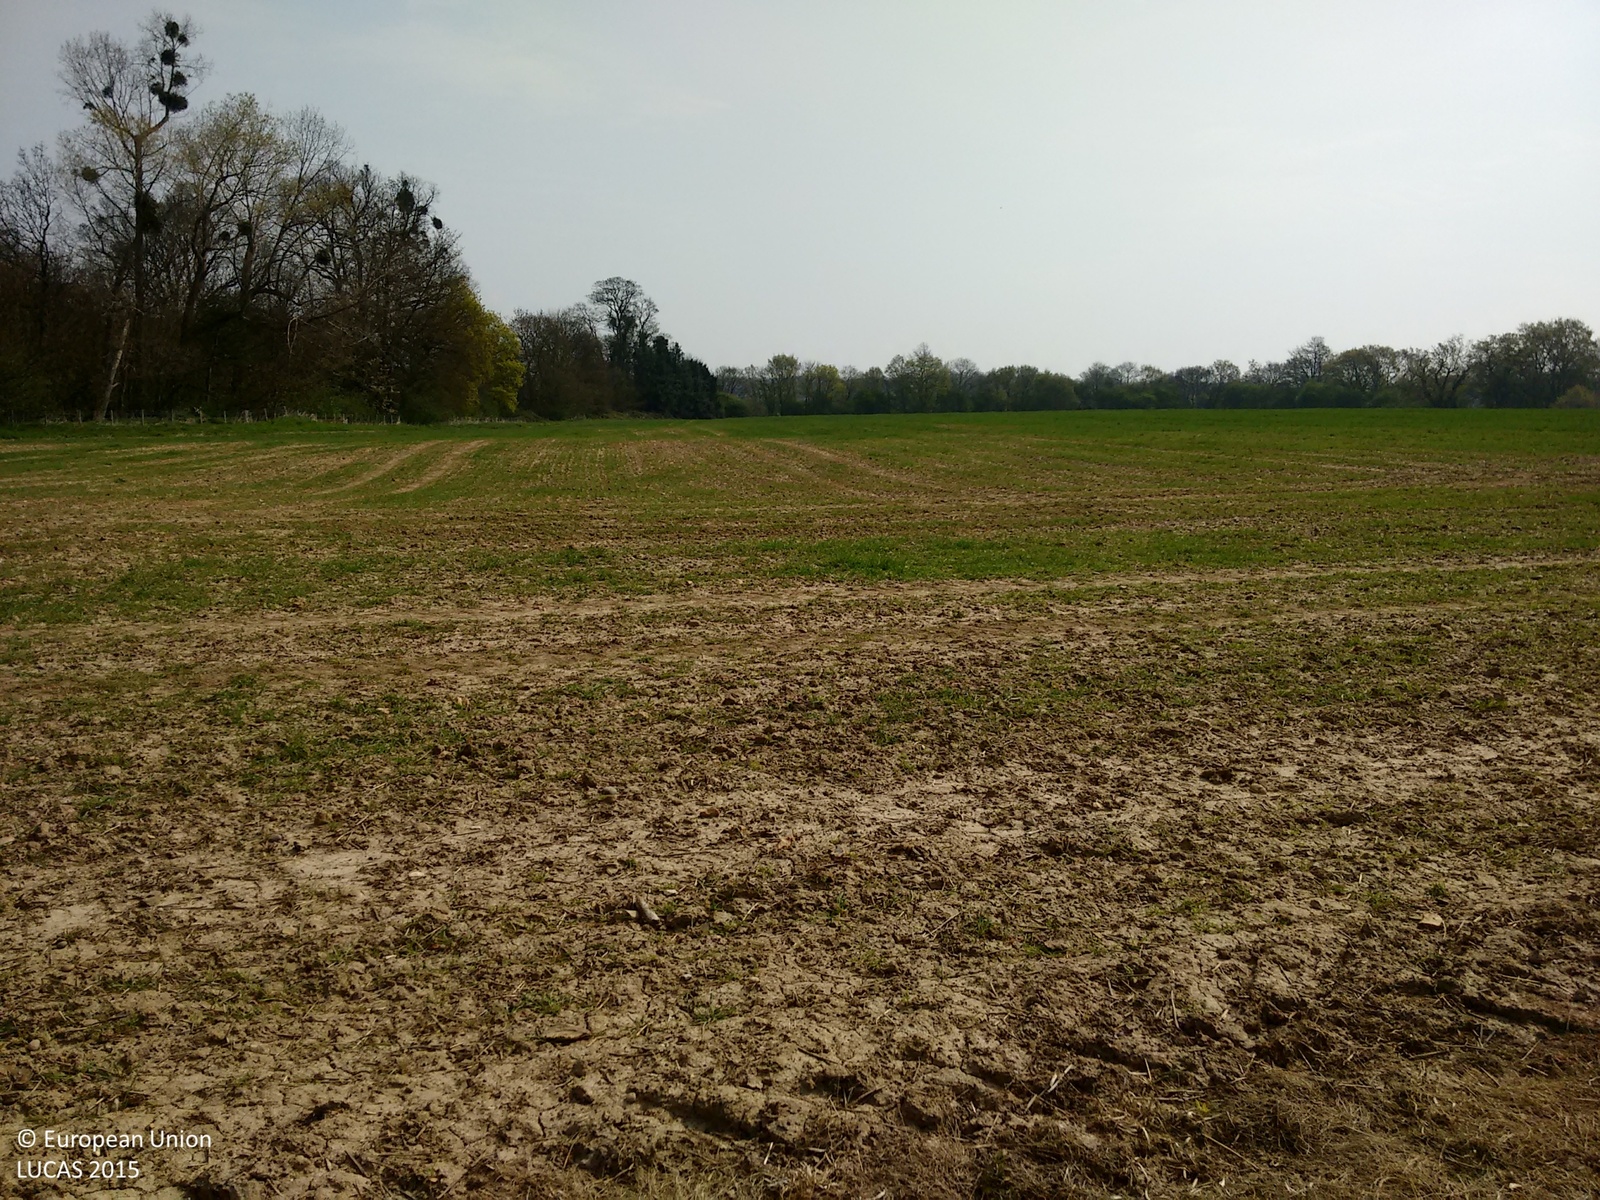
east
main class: Cropland
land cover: Common wheat
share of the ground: 25 - 50 %
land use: Agriculture (excluding fallow land and kitchen gardens)
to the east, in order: Shruby margins; Grass margins; Tracks; Common wheat
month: April
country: GB
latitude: 51.3912
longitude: 0.4144
